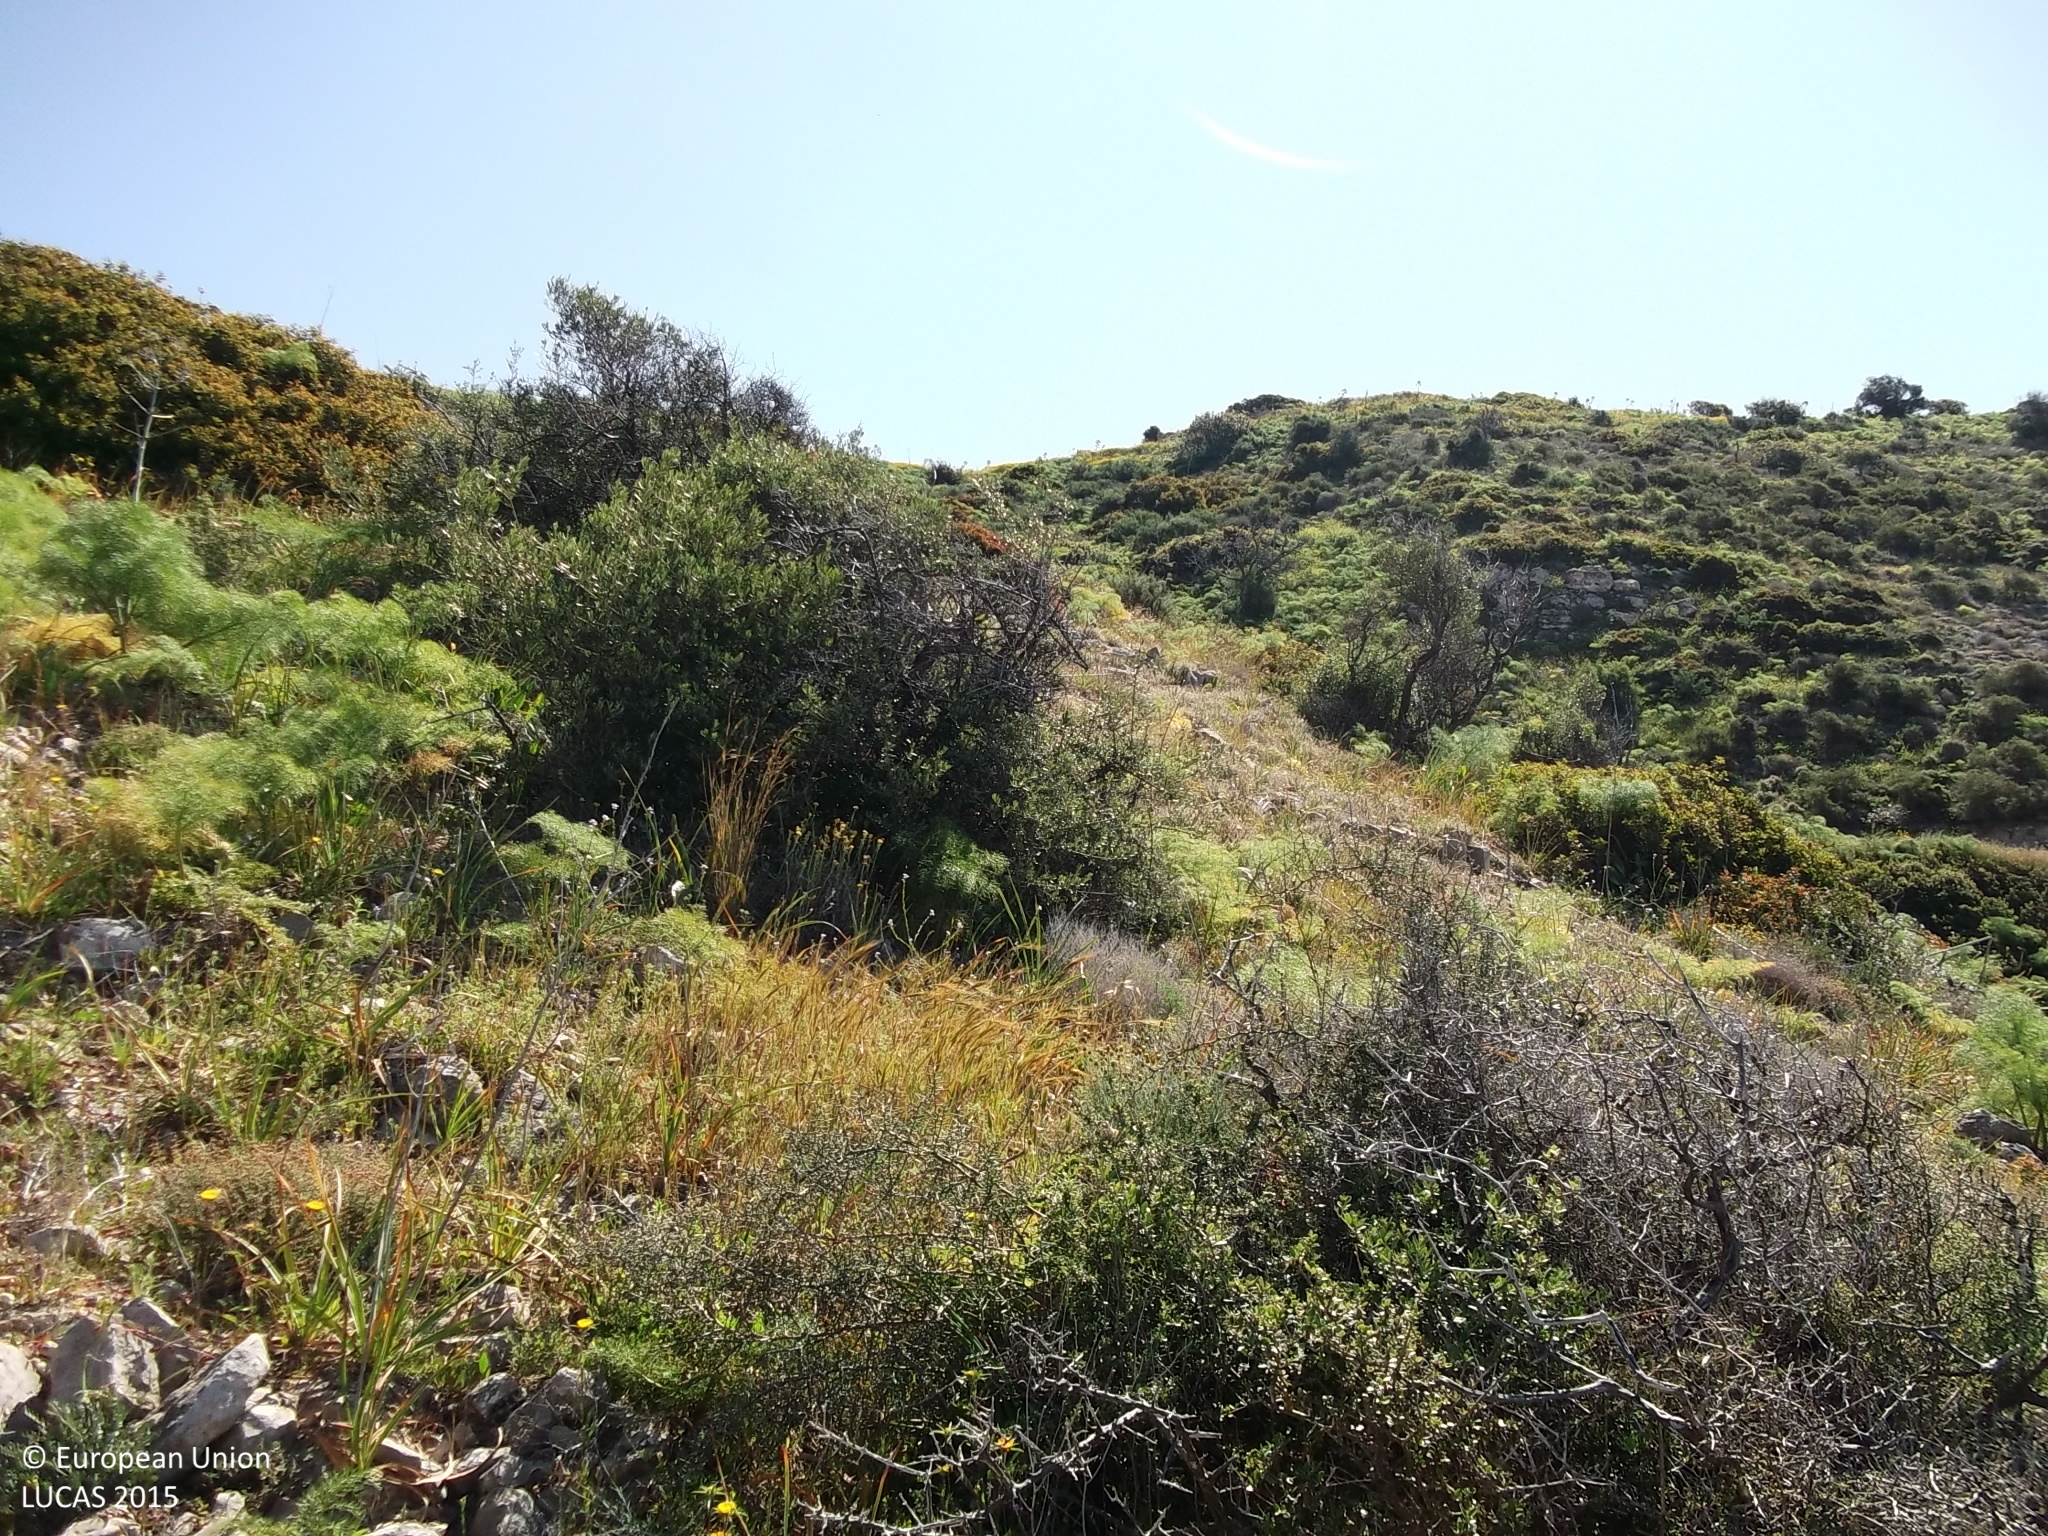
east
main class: Shrubland
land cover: Shrubland with sparse tree cover
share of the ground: 50 - 75 %
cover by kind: shrubs 45 %, herbaceous plants 40 %, unconsolidated bare surface 10 %, broadleaved forest trees 5 %
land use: Semi-natural and natural areas not in use
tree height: < 5 m
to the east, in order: Shrubland with sparse tree cover; Rock outcrops; Shrubland without tree cover; Tracks; Shrubland without tree cover; Rocks and stones; Shrubland without tree cover
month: April
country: CY
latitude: 34.7833
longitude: 33.4046
